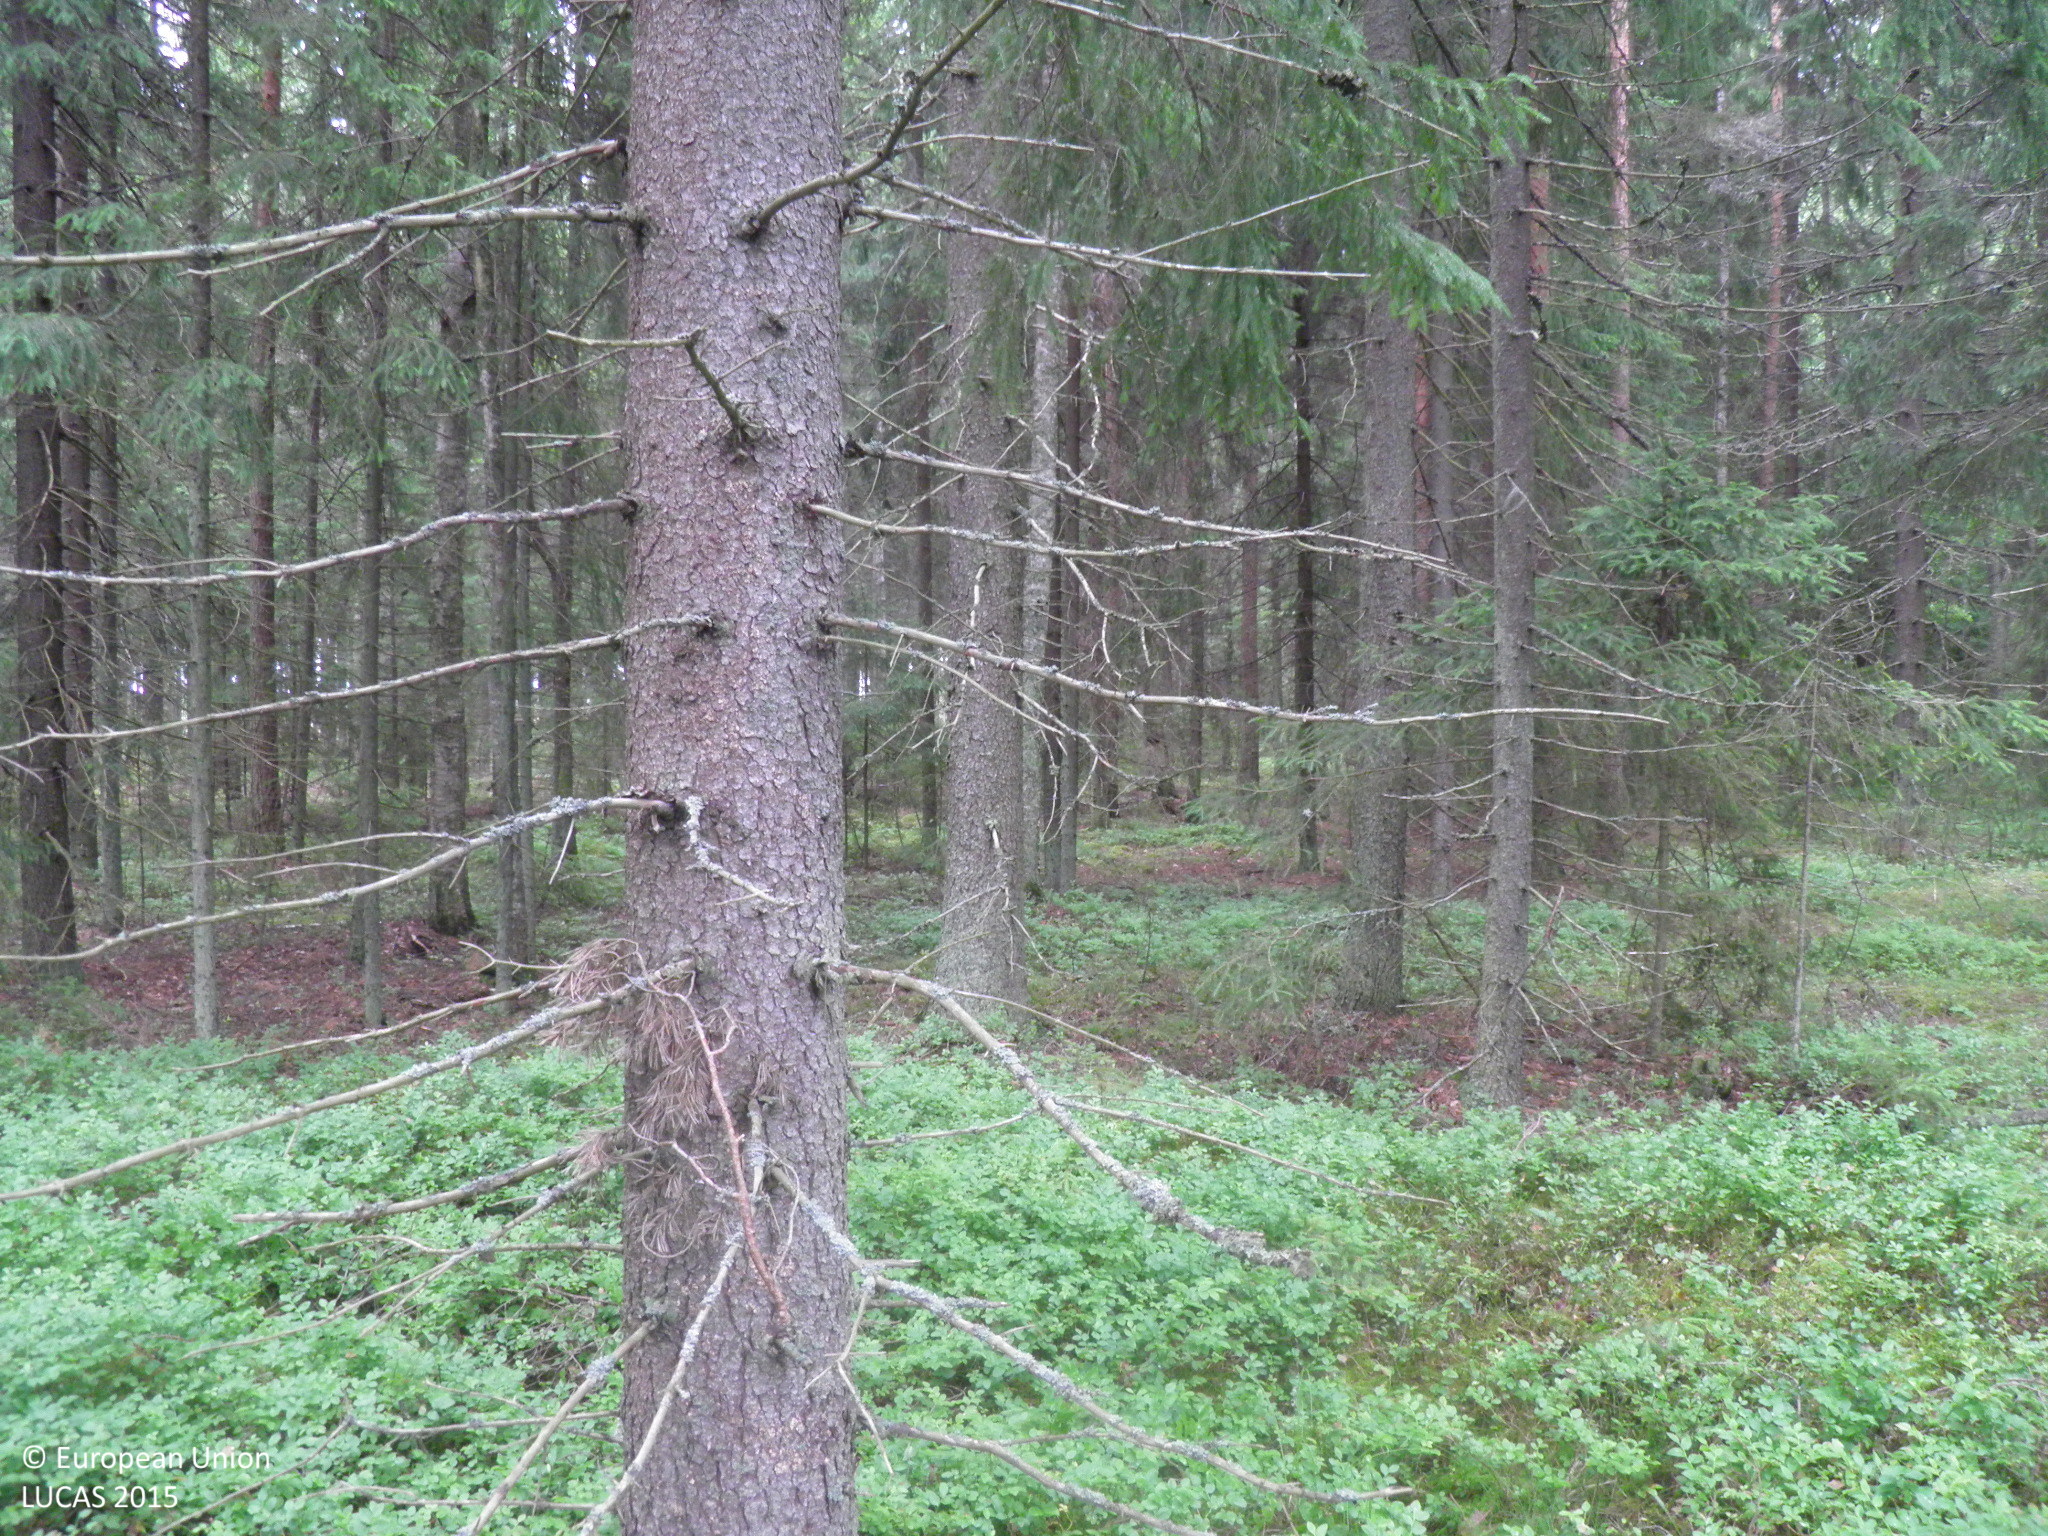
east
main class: Woodland
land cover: Spruce dominated coniferous woodland
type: boreal forest
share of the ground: > 75 %
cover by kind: coniferous forest trees 60 %, broadleaved forest trees 15 %, shrubs 15 %, lichens and mosses 10 %
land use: Forestry
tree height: > 5 m
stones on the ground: < 10 %
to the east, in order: Spruce dominated coniferous woodland; Tracks; Spruce dominated coniferous woodland
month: July
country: FI
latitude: 60.7054
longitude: 22.8442
